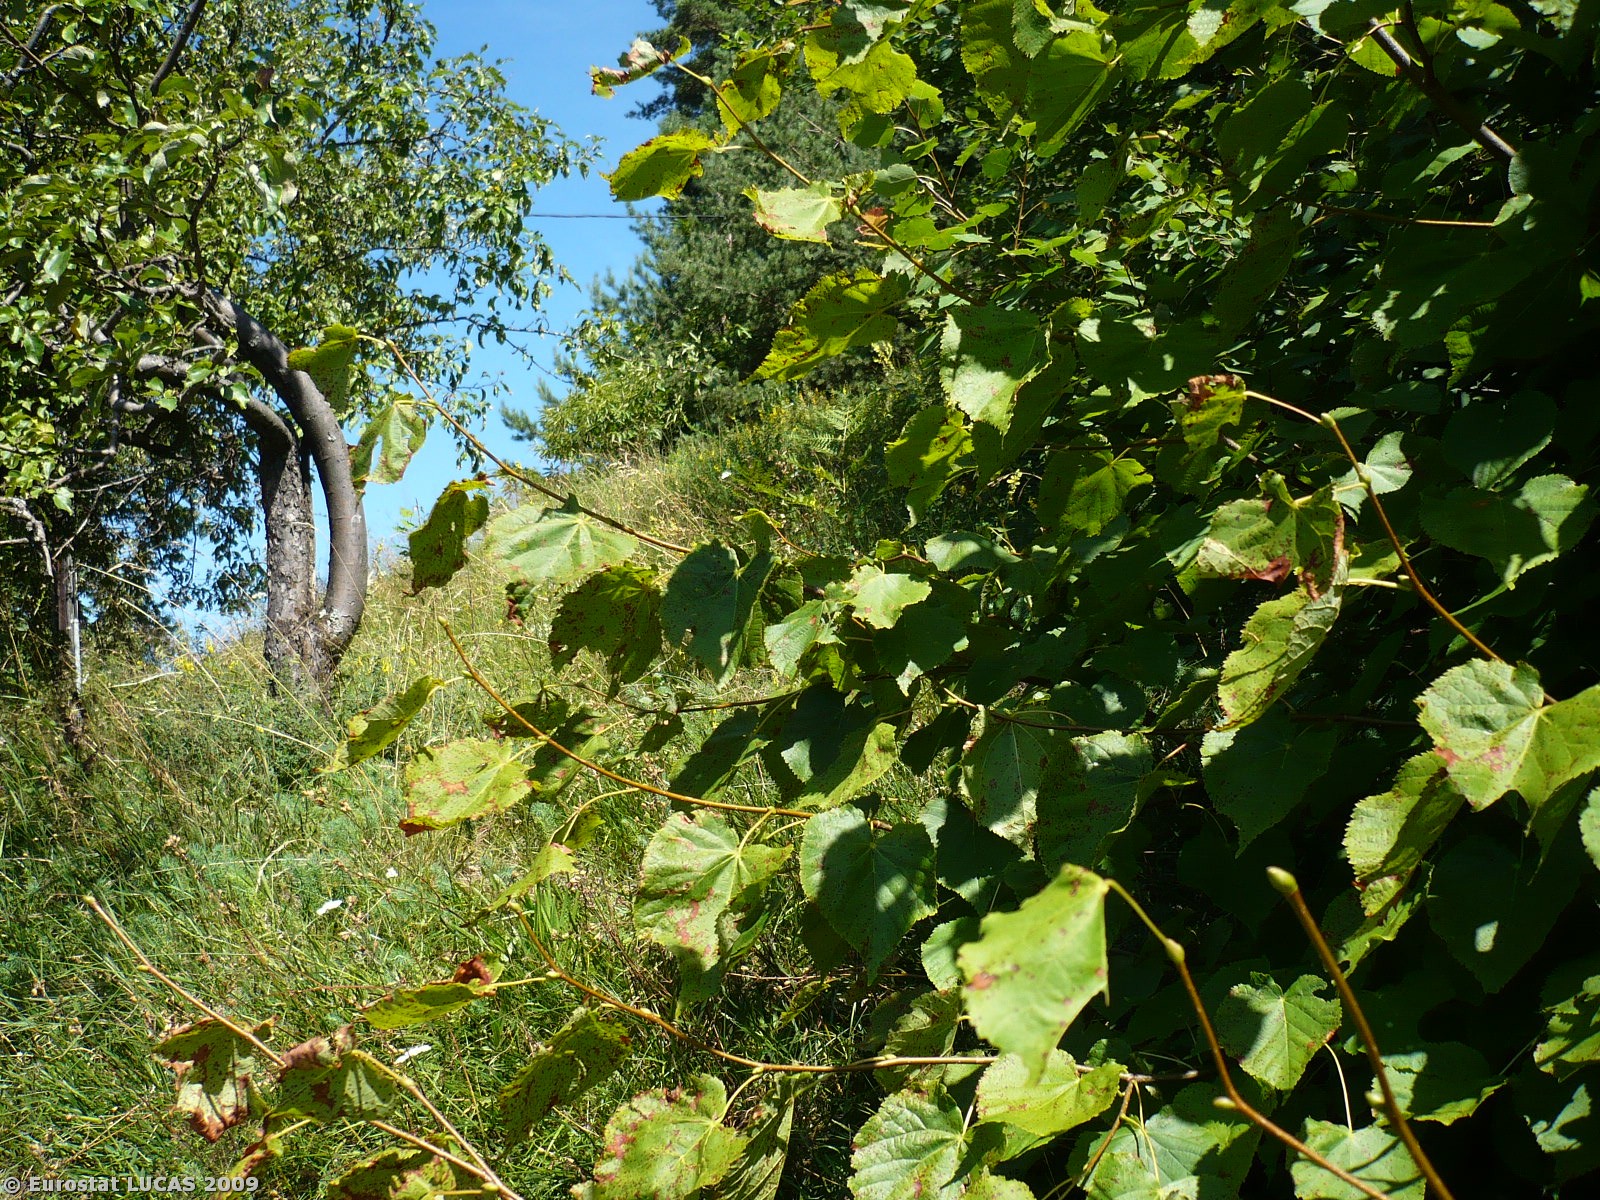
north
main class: Shrubland
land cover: Shrubland with sparse tree cover
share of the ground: > 75 %
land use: Unused
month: July
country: SI
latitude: 46.6149
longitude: 15.3393
